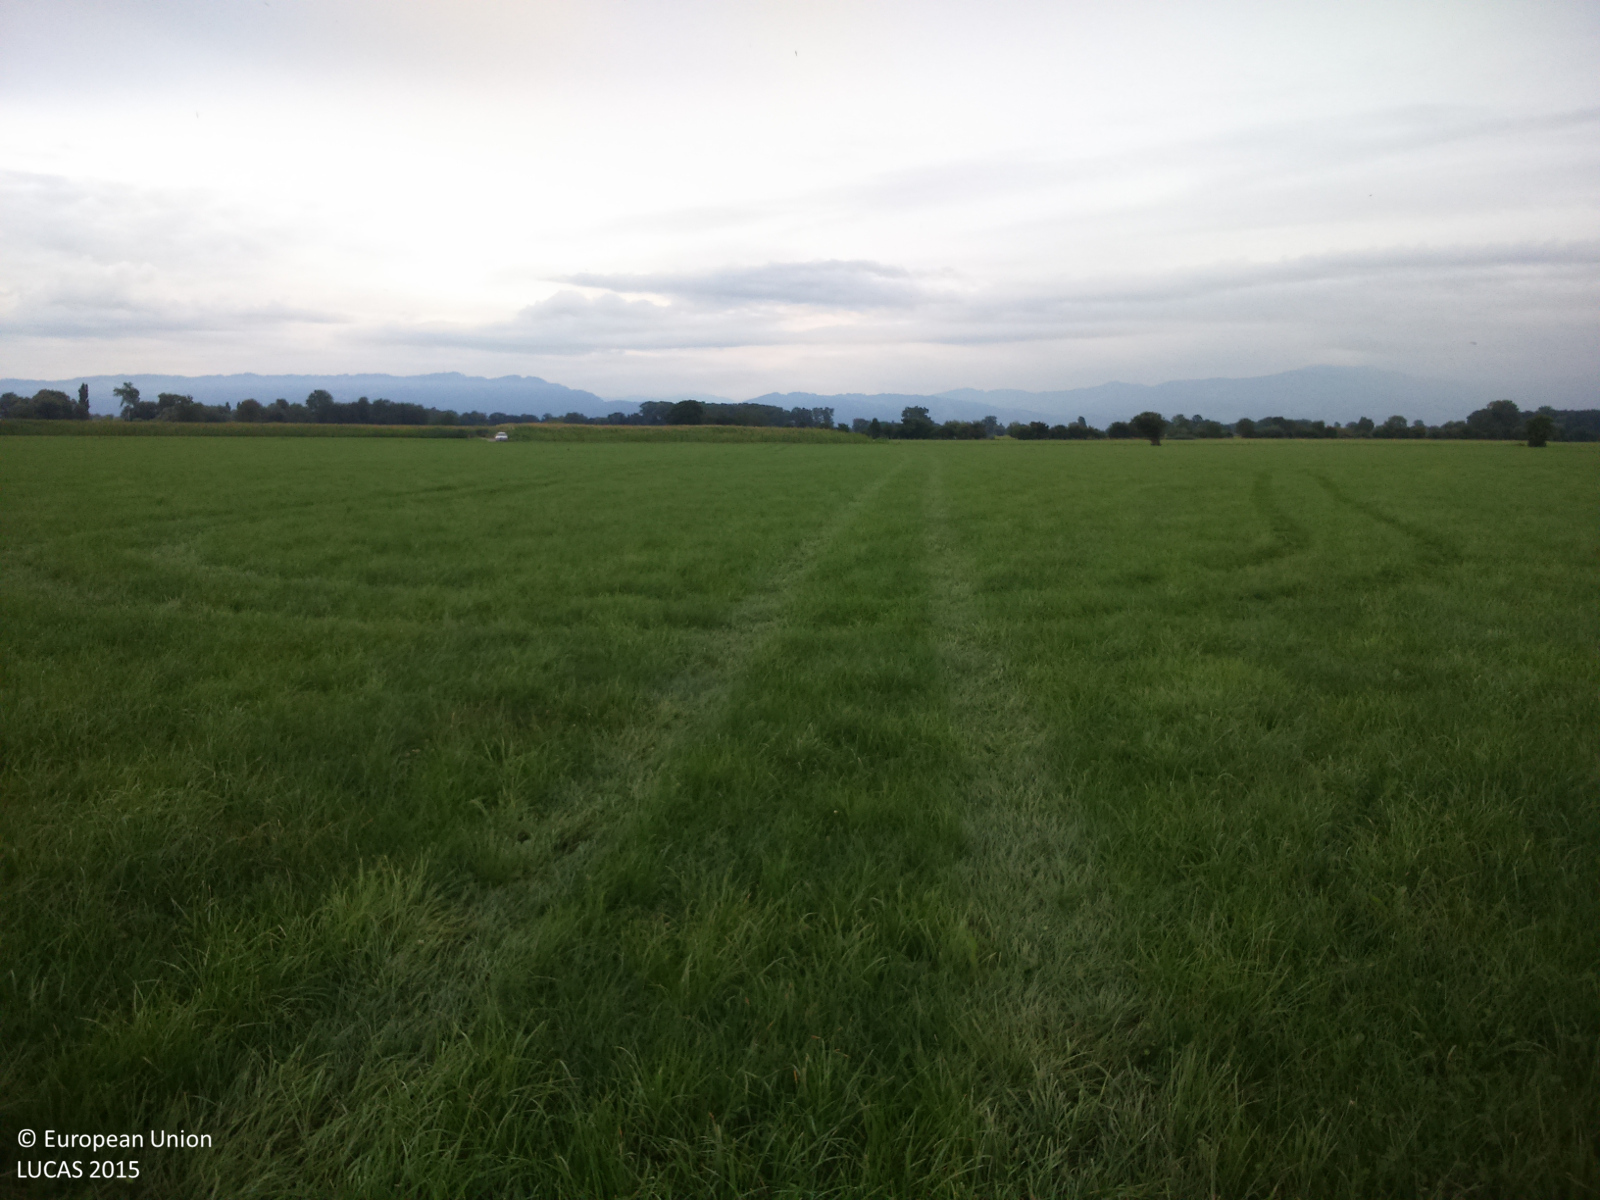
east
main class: Grassland
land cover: Grassland without tree/shrub cover
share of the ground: > 75 %
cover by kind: herbaceous plants 100 %
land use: Agriculture (excluding fallow land and kitchen gardens)
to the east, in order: Grassland without tree/shrub cover; Tracks; Ditches and canals; Grass margins; Maize
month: August
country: AT
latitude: 47.4848
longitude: 9.5890
